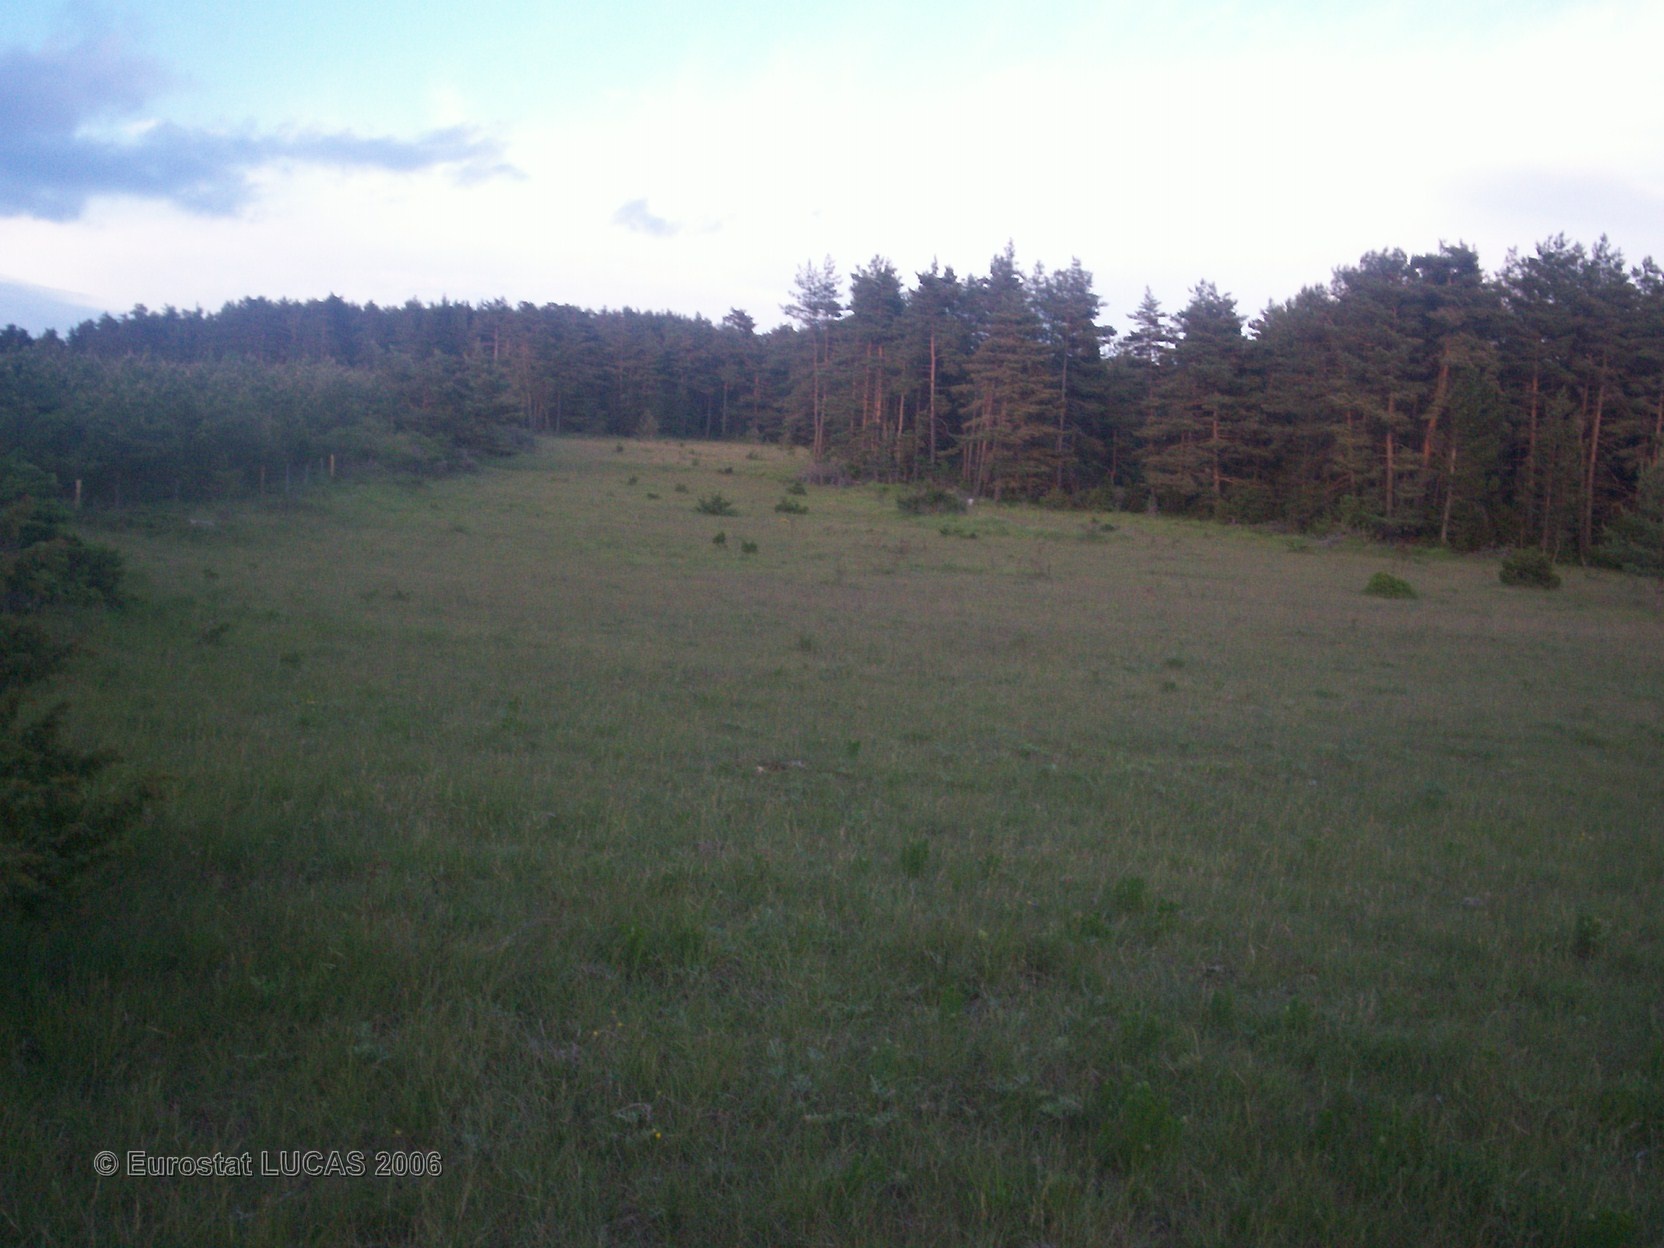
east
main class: Grassland
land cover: Grassland without tree/shrub cover
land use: Agriculture (excluding fallow land and kitchen gardens)
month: June
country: FR
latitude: 44.4484
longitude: 3.4082
